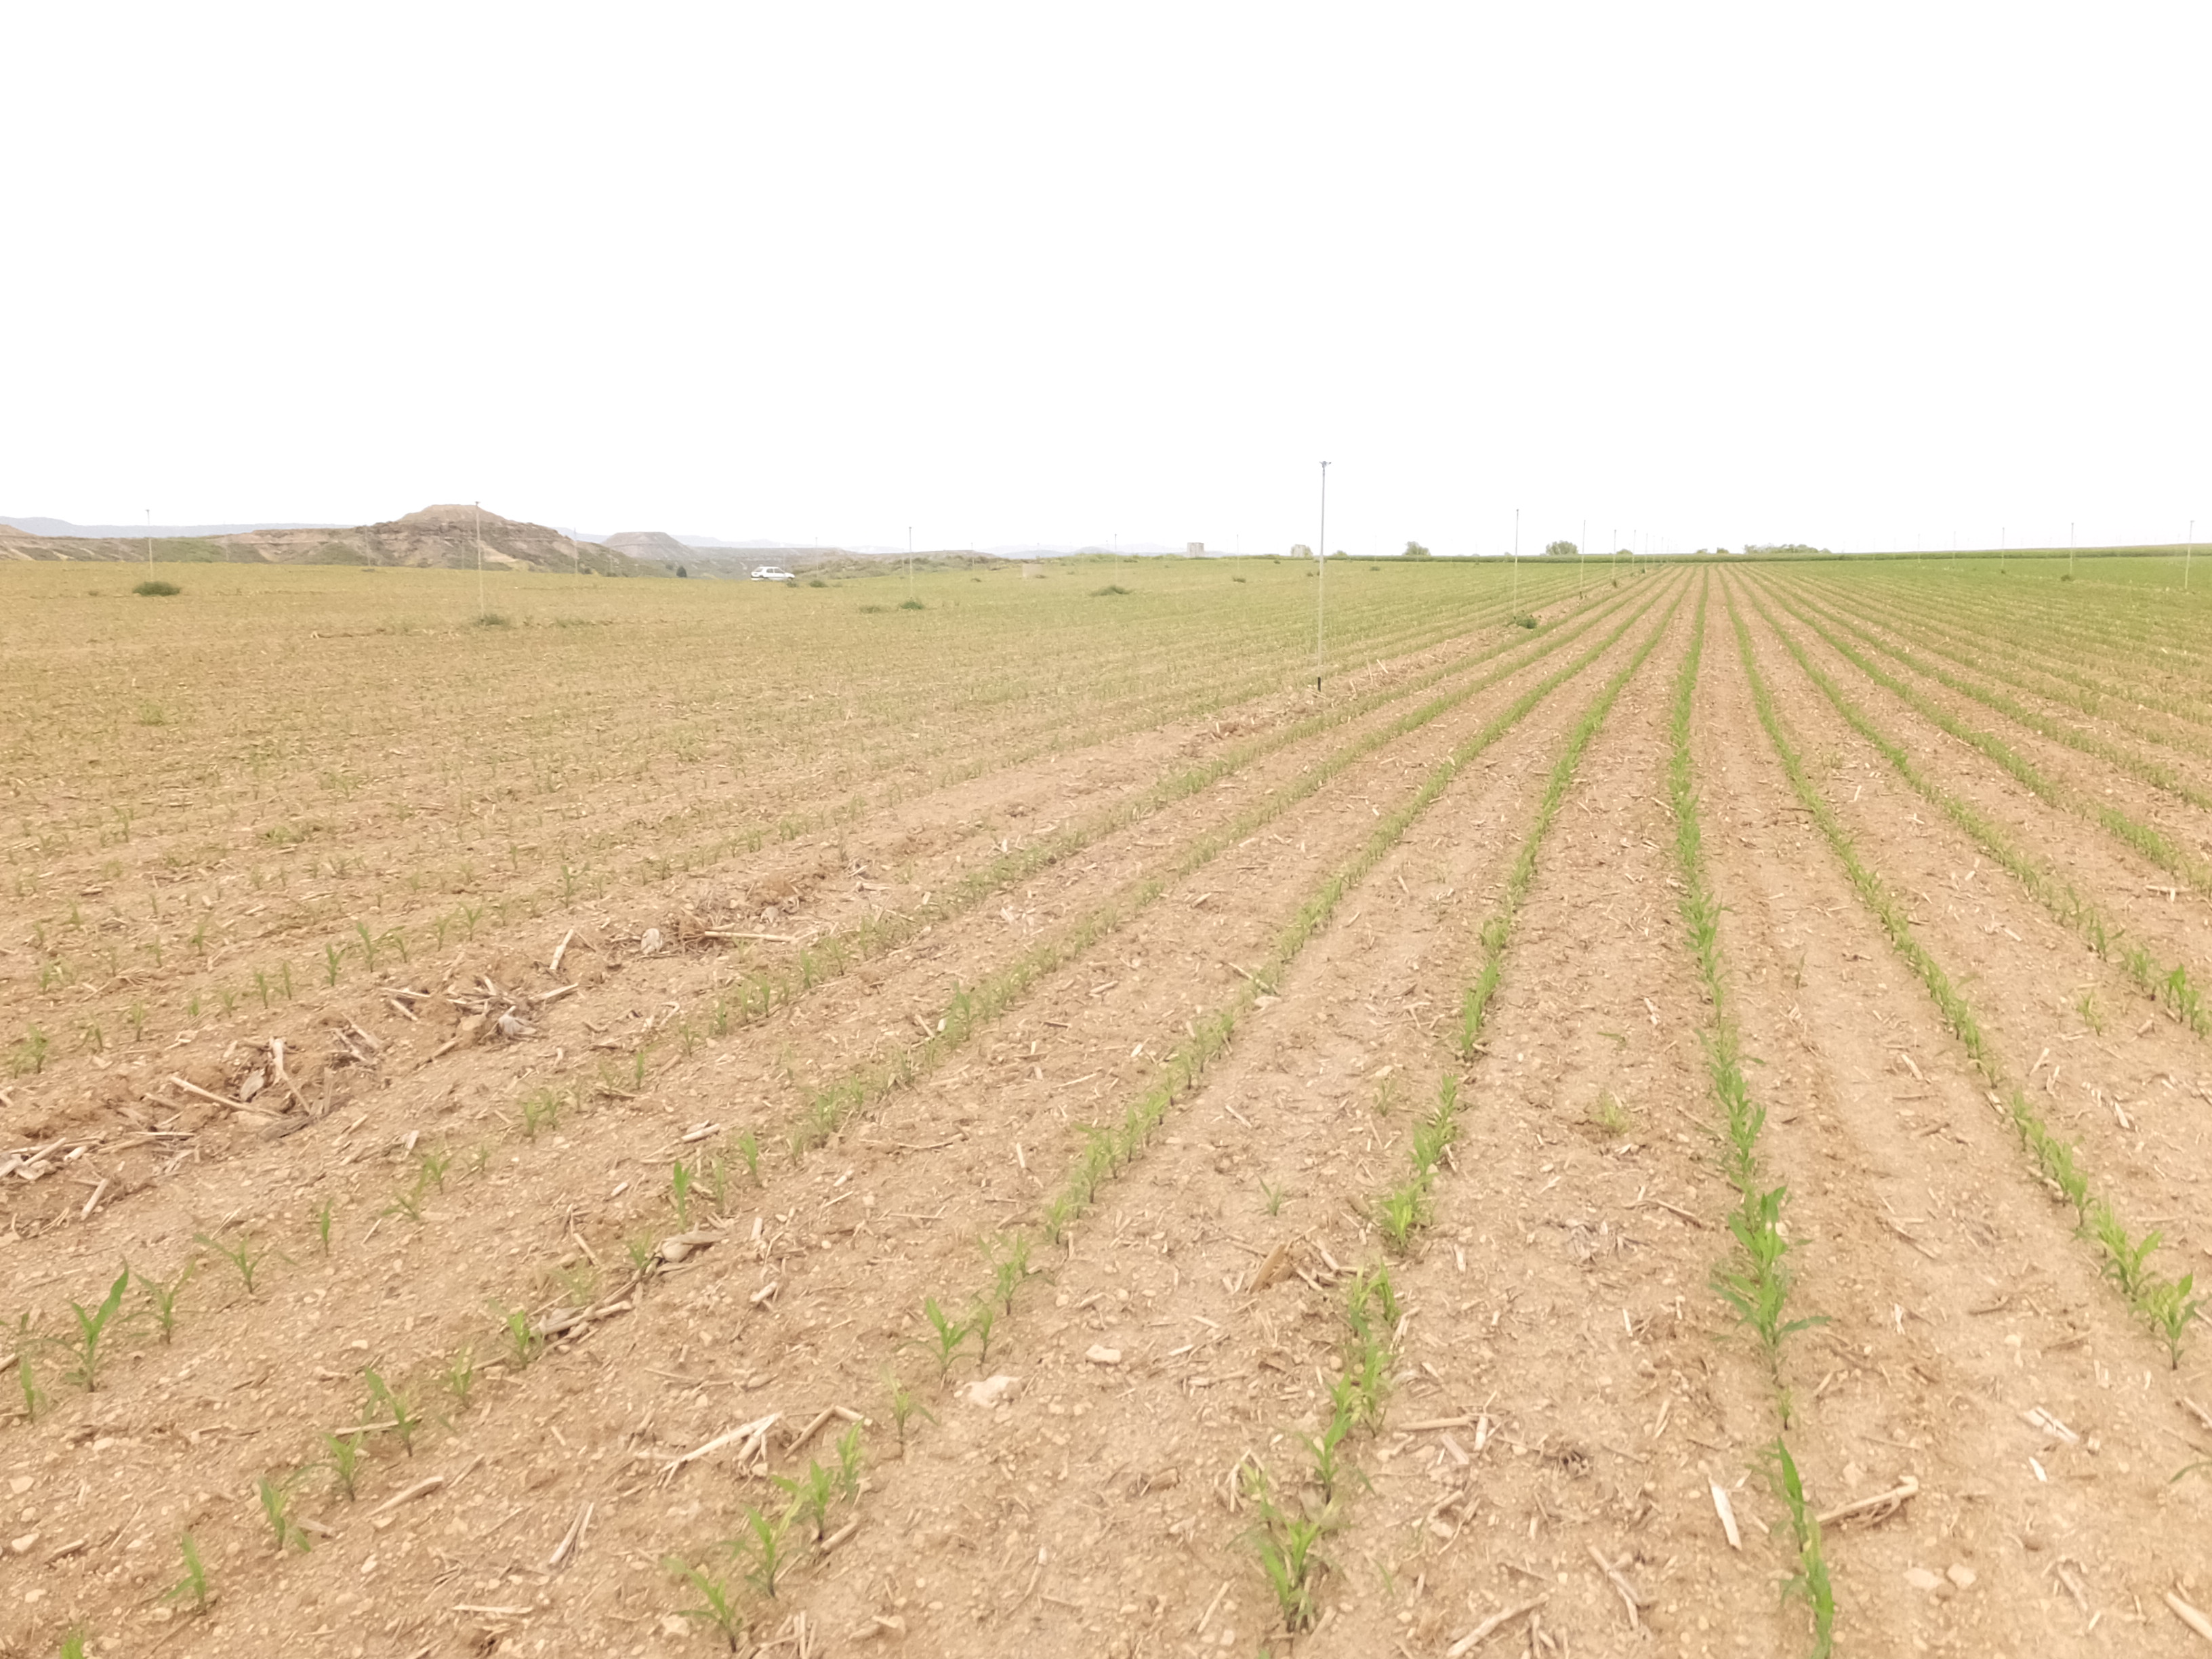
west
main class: Cropland
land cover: Maize
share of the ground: < 10 %
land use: Agriculture (excluding fallow land and kitchen gardens)
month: May
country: ES
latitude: 41.7170
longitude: -0.2225
